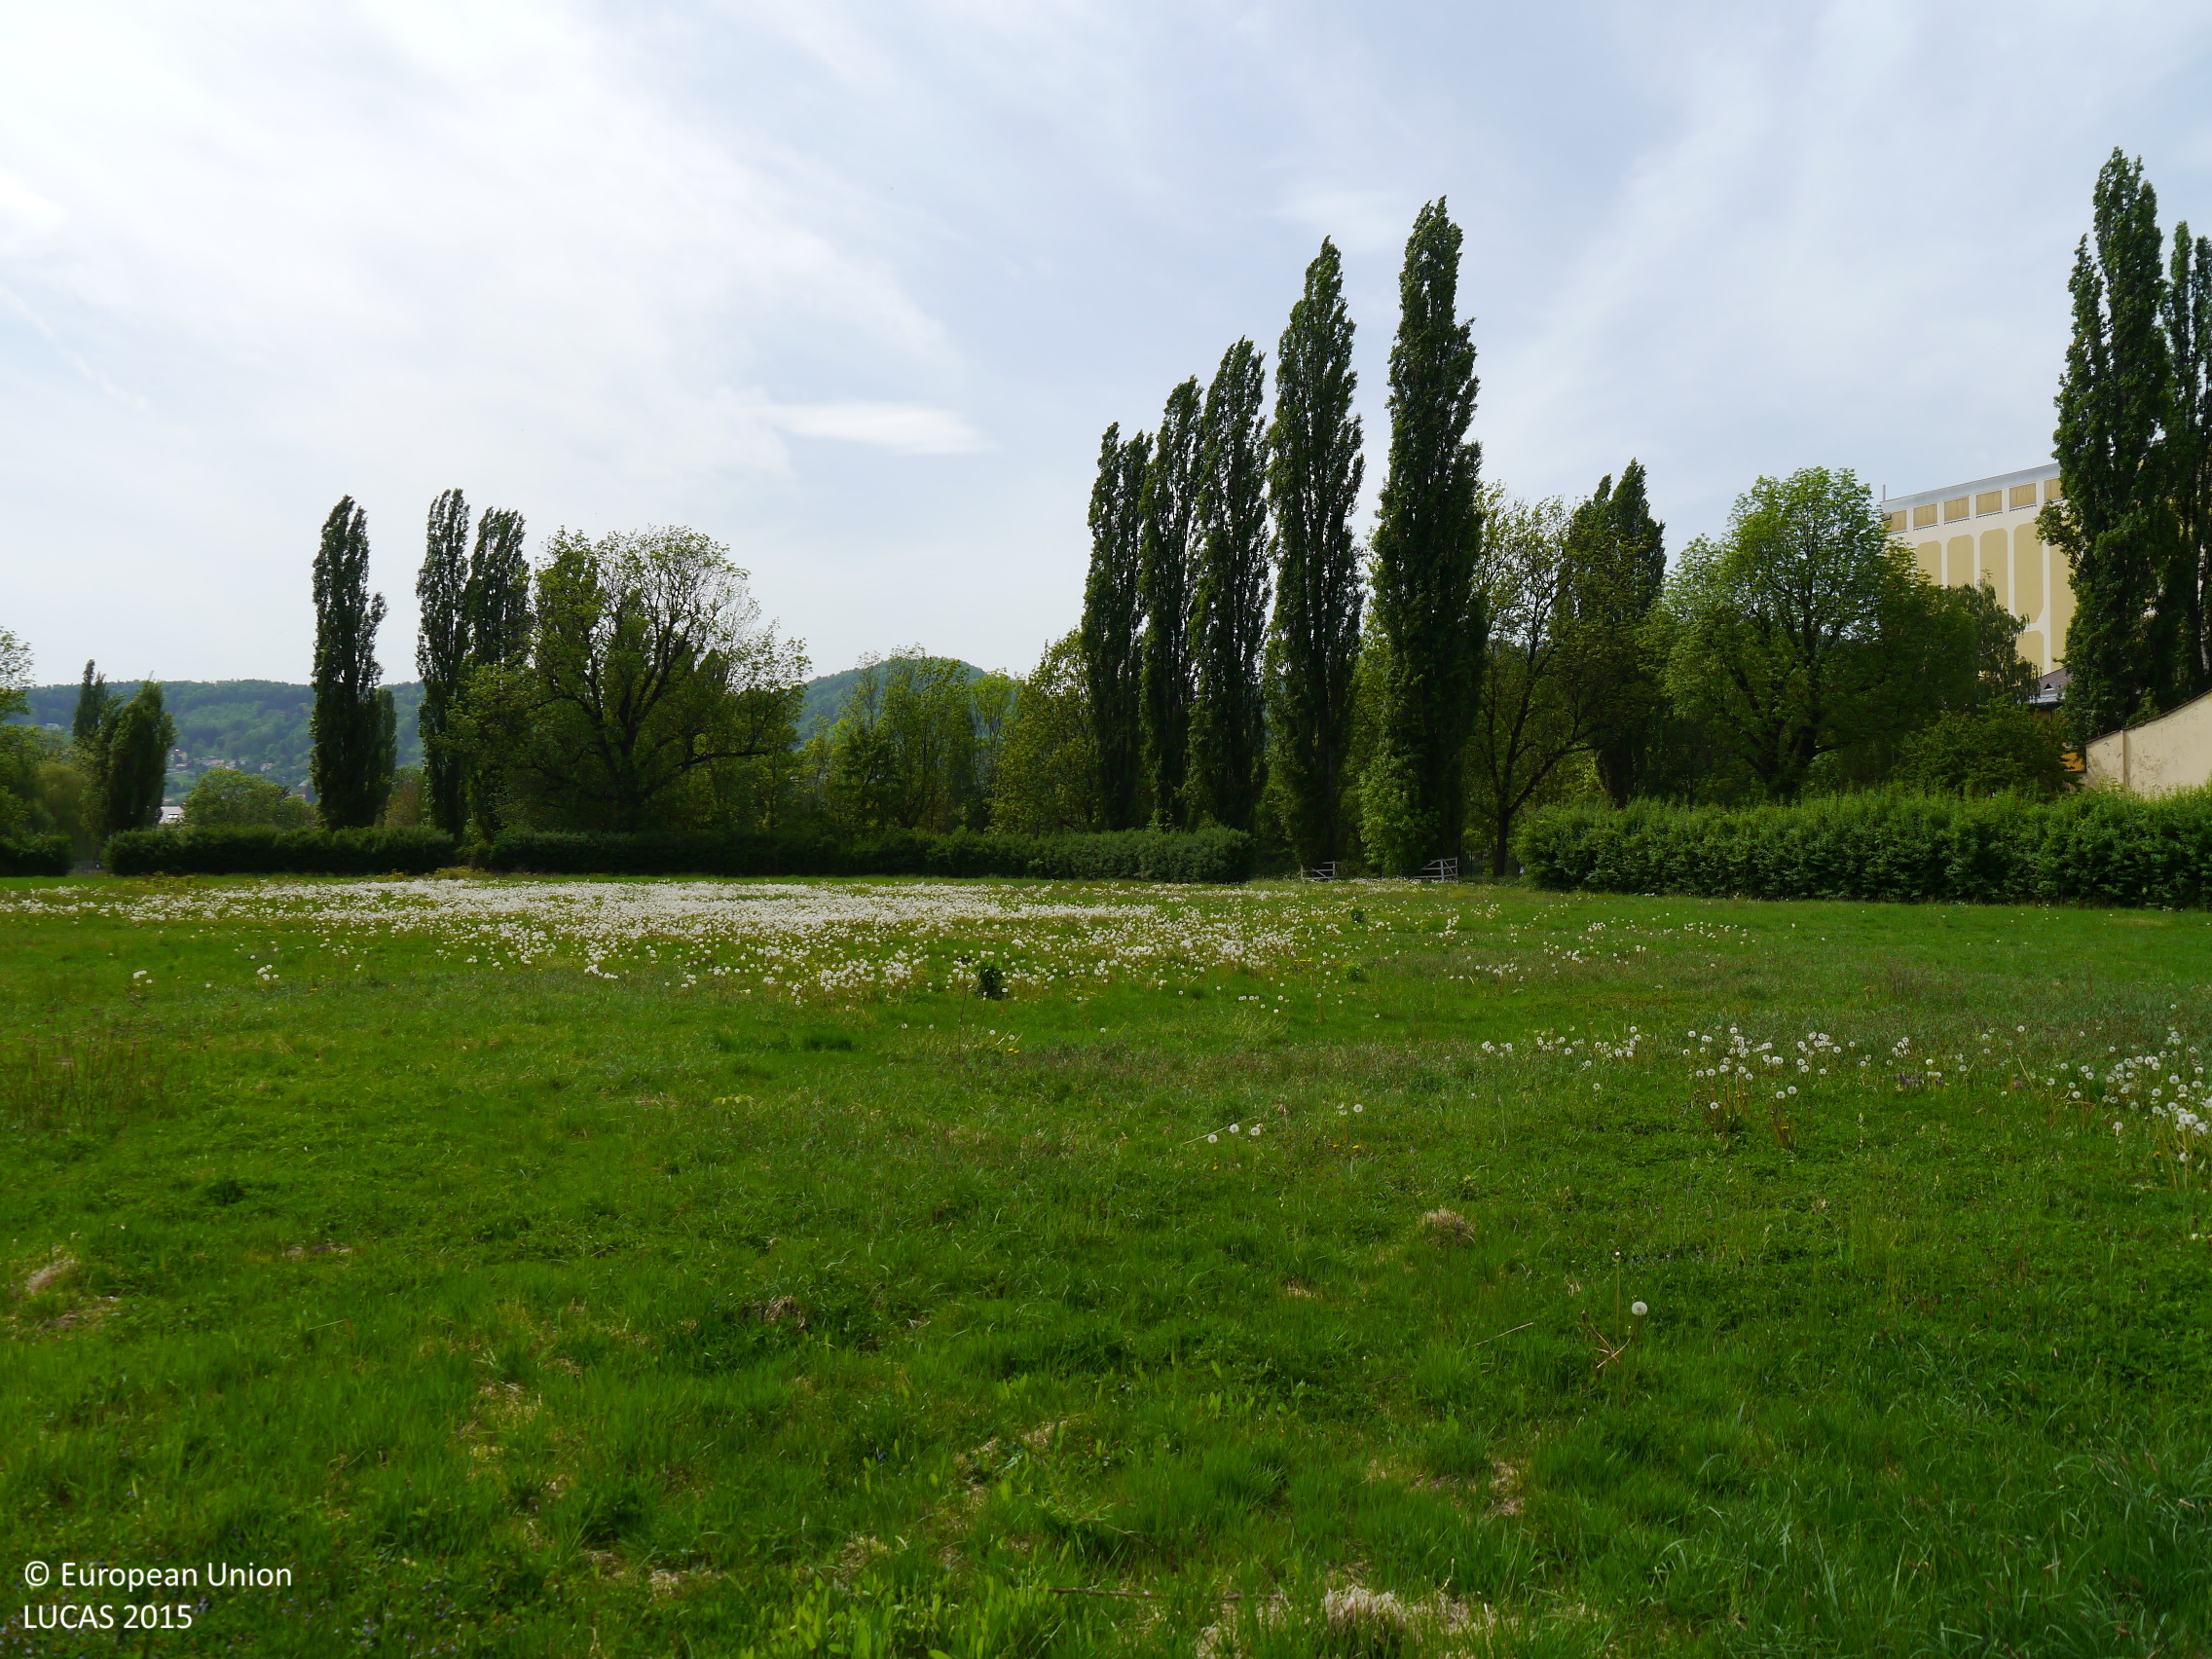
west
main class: Grassland
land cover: Grassland without tree/shrub cover
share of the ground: > 75 %
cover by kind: herbaceous plants 100 %
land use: Sport
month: May
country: AT
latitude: 47.0625
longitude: 15.4112
